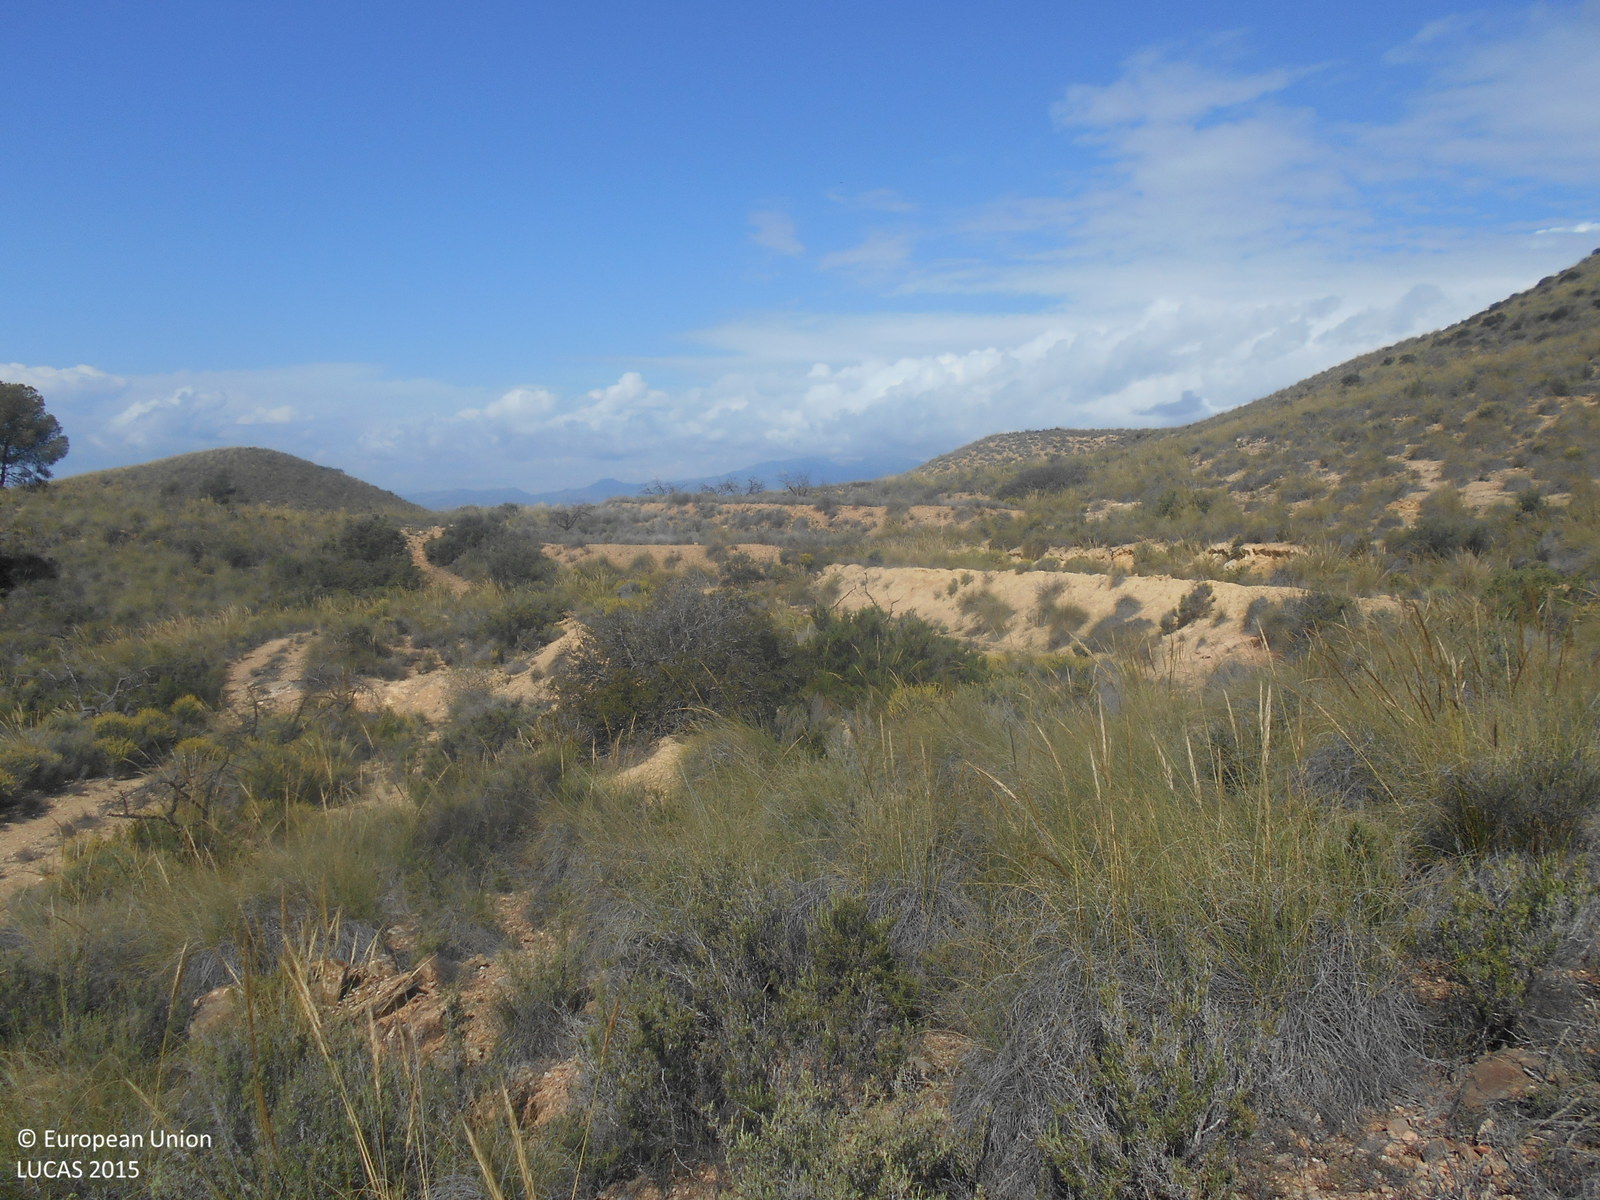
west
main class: Shrubland
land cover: Shrubland without tree cover
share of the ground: > 75 %
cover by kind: shrubs 80 %, unconsolidated bare surface 15 %, consolidated bare surface 5 %
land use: Semi-natural and natural areas not in use
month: April
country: ES
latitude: 37.8001
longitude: -1.3282
